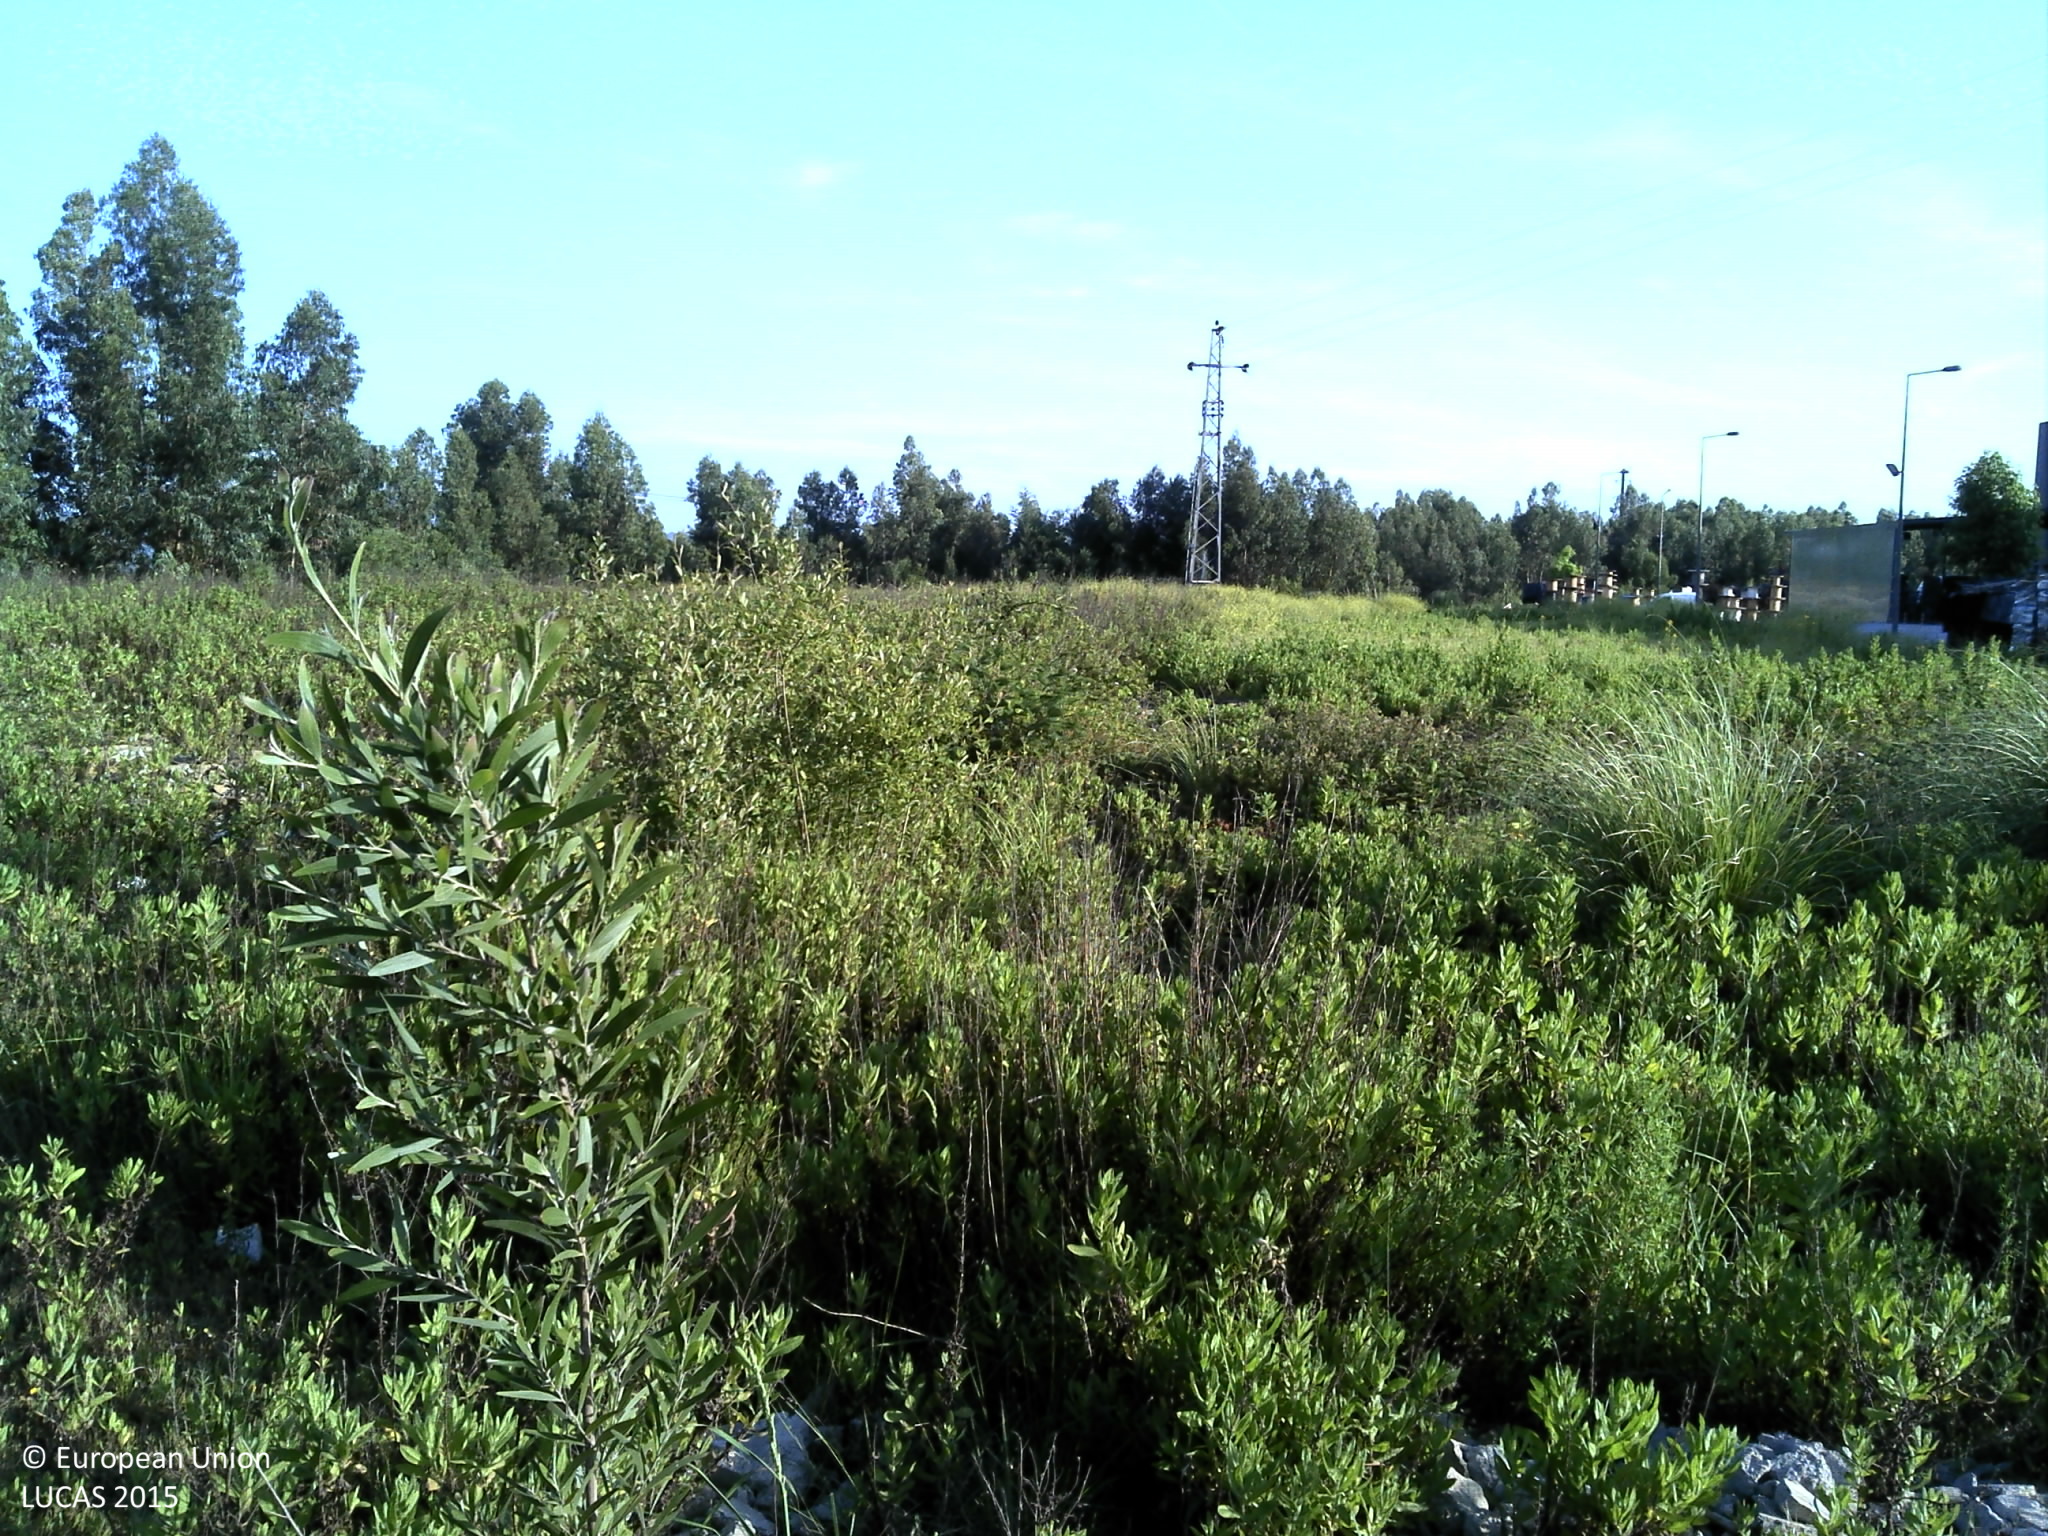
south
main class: Grassland
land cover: Spontaneously vegetated surfaces
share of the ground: 25 - 50 %
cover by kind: herbaceous plants 50 %, unconsolidated bare surface 50 %
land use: Abandoned areas
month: May
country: PT
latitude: 41.3700
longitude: -8.5297
